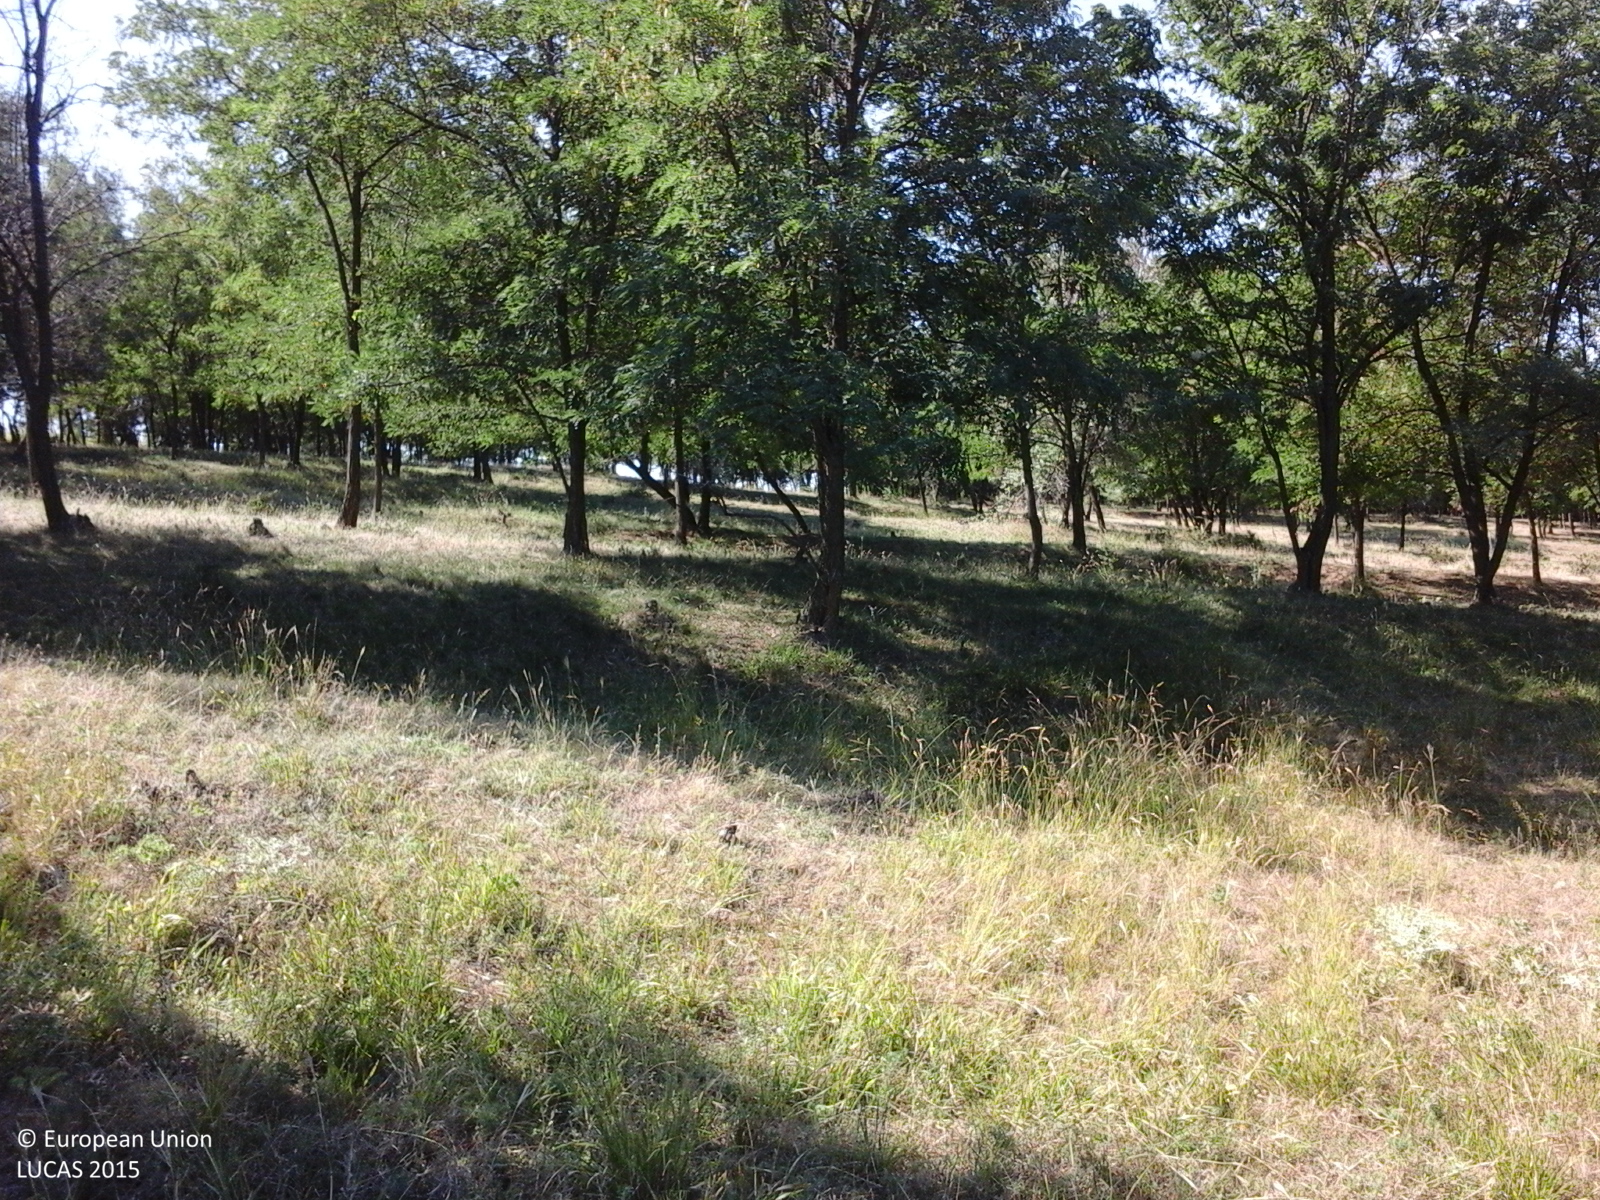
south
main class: Woodland
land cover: Broadleaved woodland
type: exotic forest
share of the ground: > 75 %
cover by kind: broadleaved forest trees 100 %
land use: Forestry
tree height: > 5 m
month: July
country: RO
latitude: 46.0305
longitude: 27.7497
